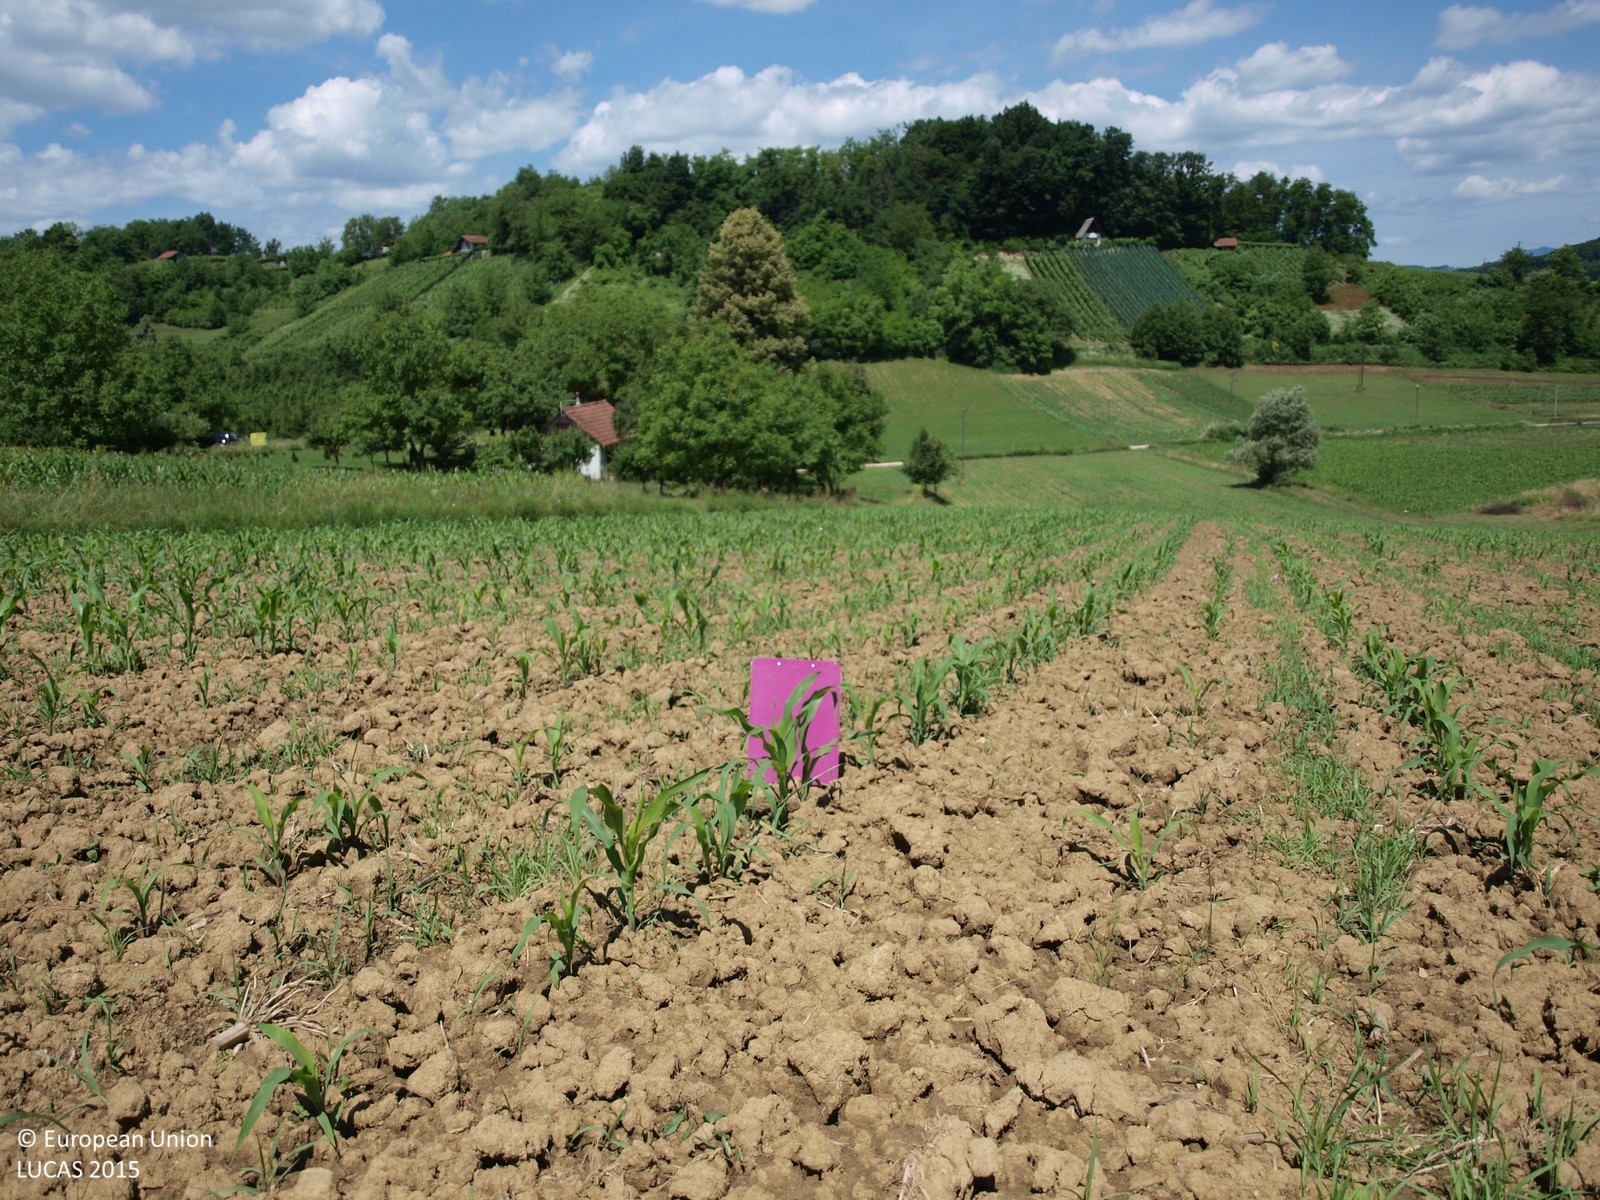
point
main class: Cropland
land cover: Maize
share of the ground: 25 - 50 %
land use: Agriculture (excluding fallow land and kitchen gardens)
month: June
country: HR
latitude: 46.0908
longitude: 15.7018
